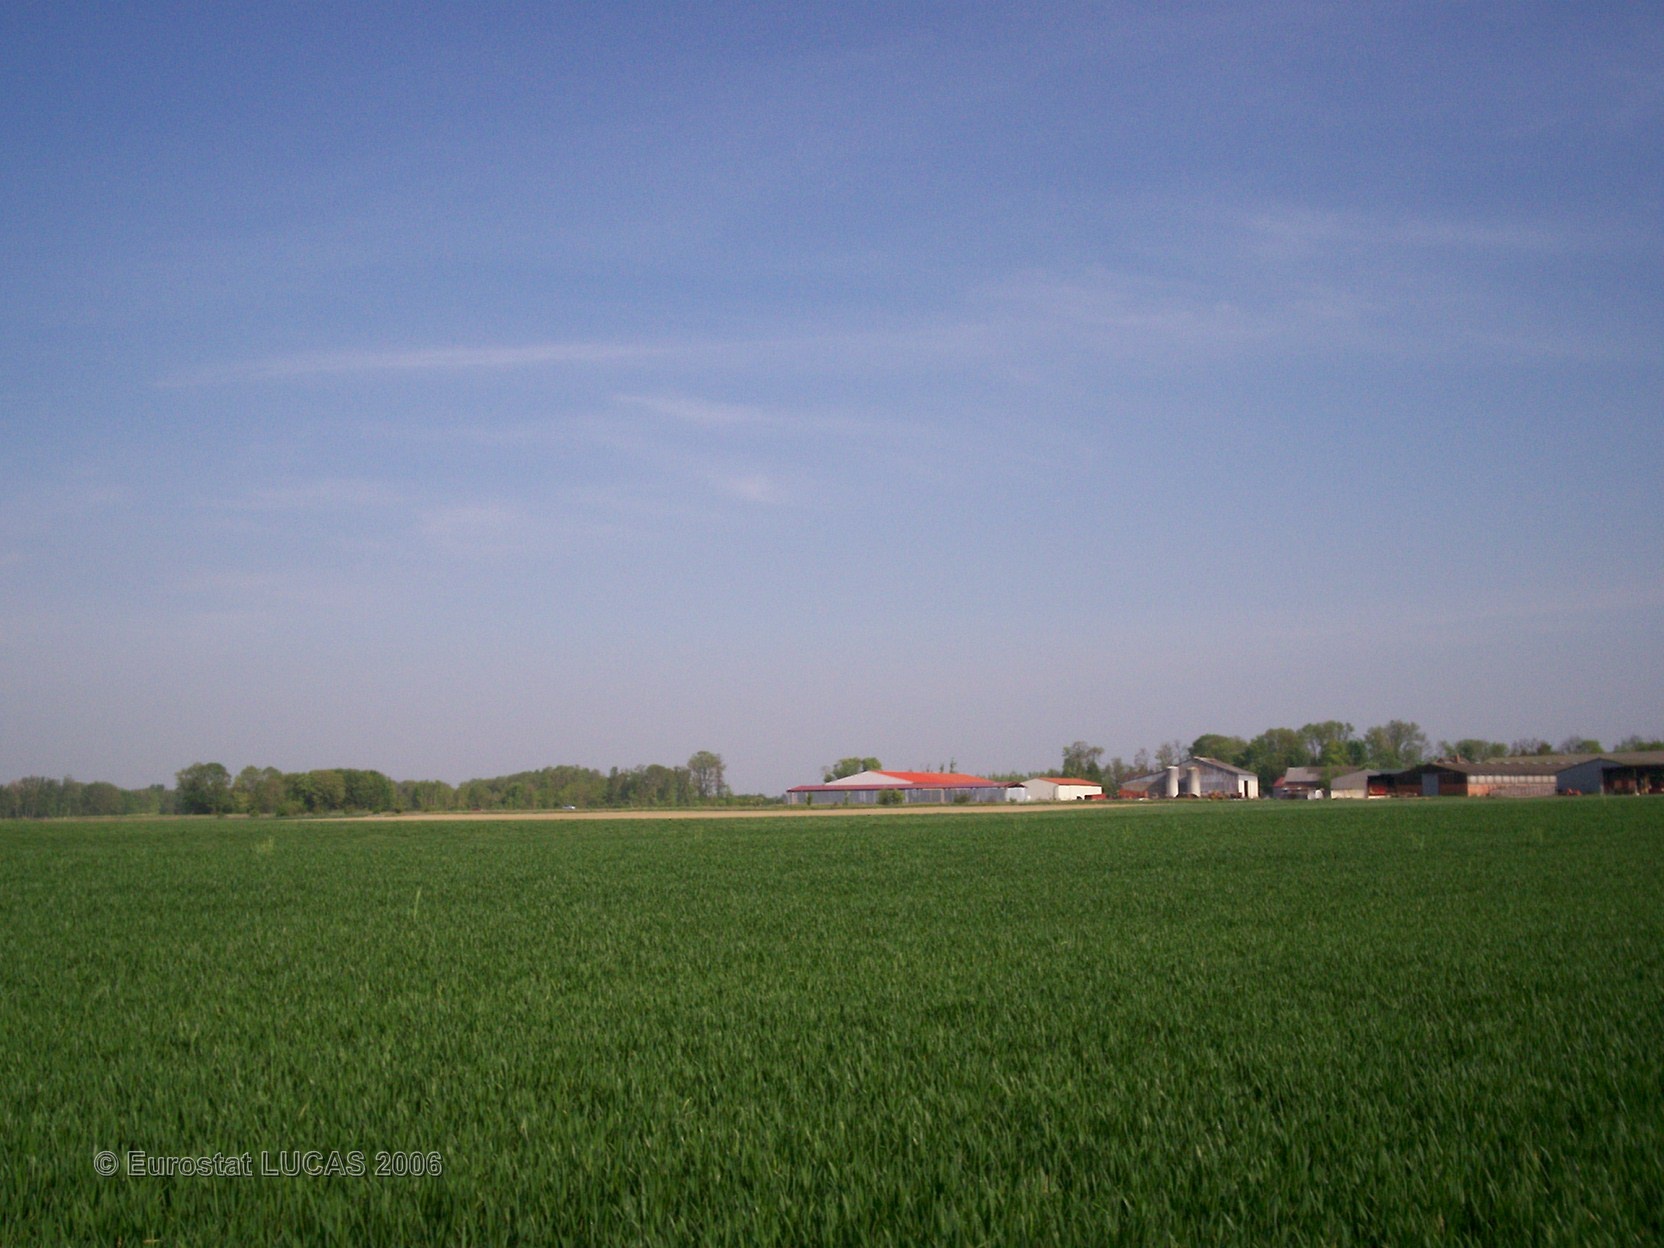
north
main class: Cropland
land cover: Common wheat
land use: Agriculture (excluding fallow land and kitchen gardens)
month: May
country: FR
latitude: 49.0564
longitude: 4.4269
